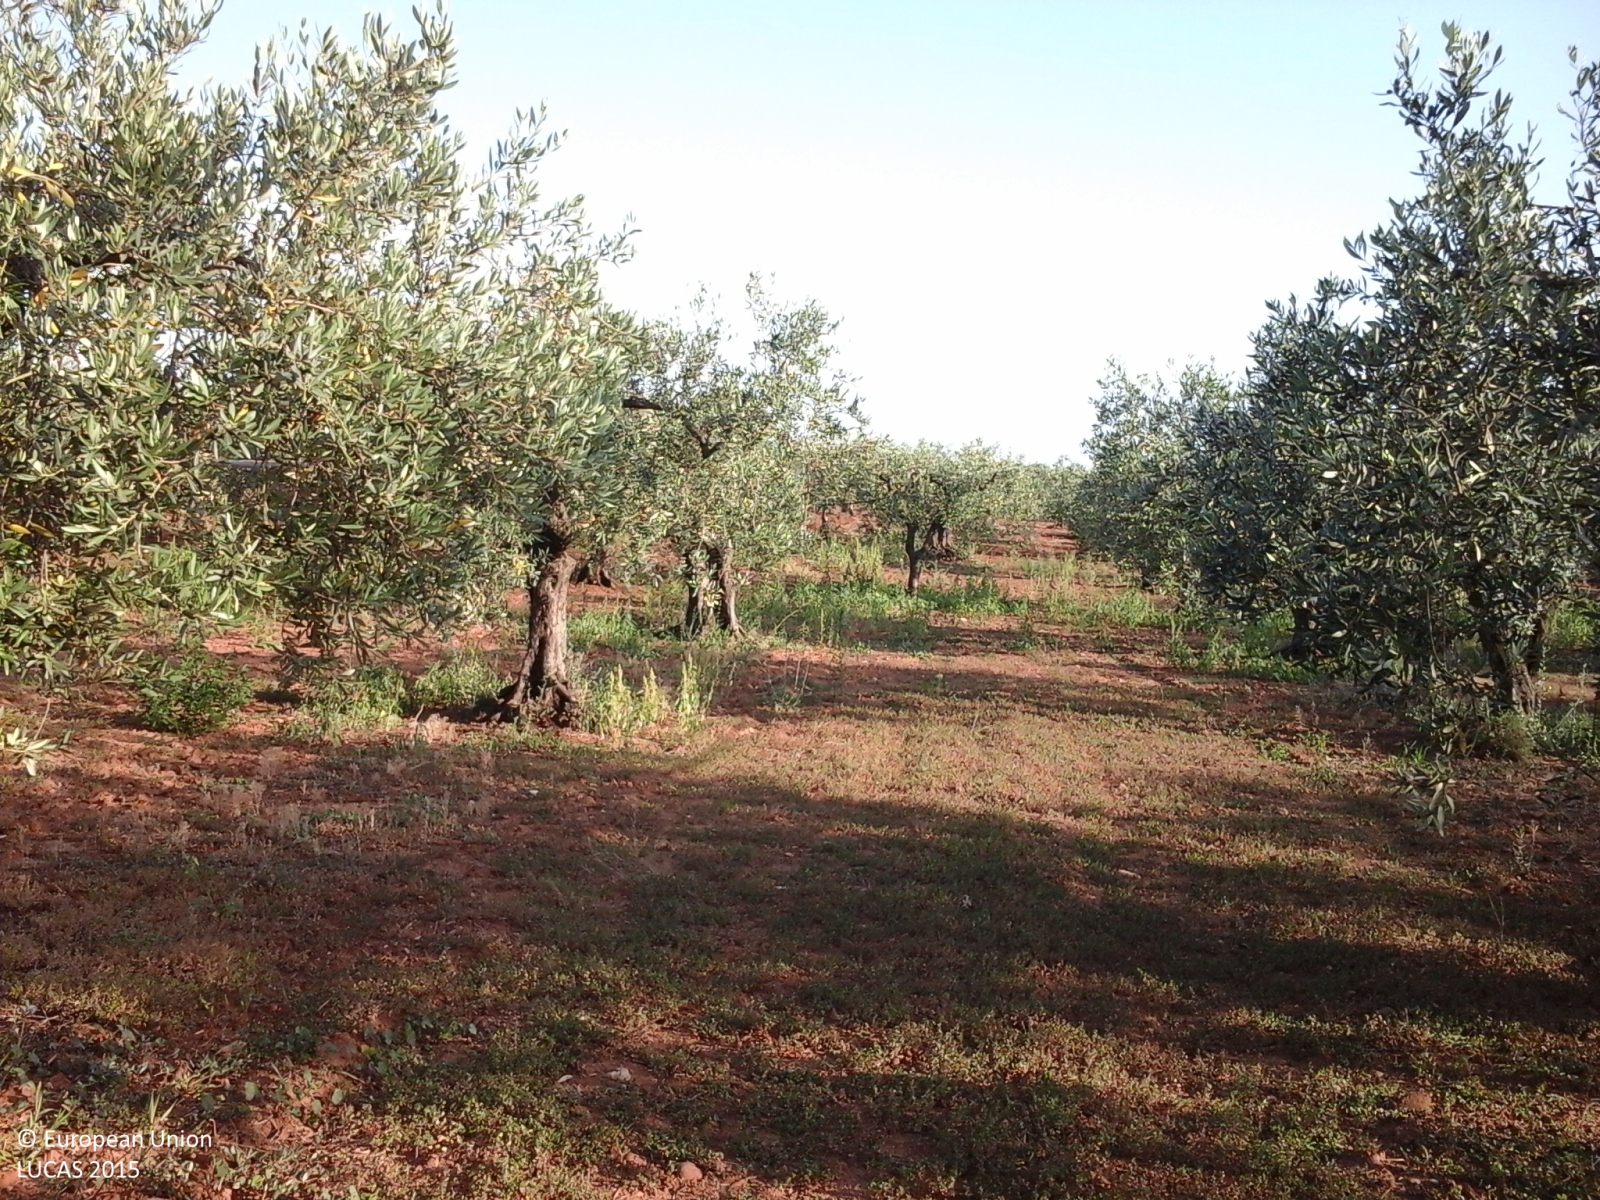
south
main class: Cropland
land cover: Olive groves
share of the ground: > 75 %
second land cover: Other bare soil
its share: > 75 %
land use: Agriculture (excluding fallow land and kitchen gardens)
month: May
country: IT
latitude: 37.6868
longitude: 12.8475
